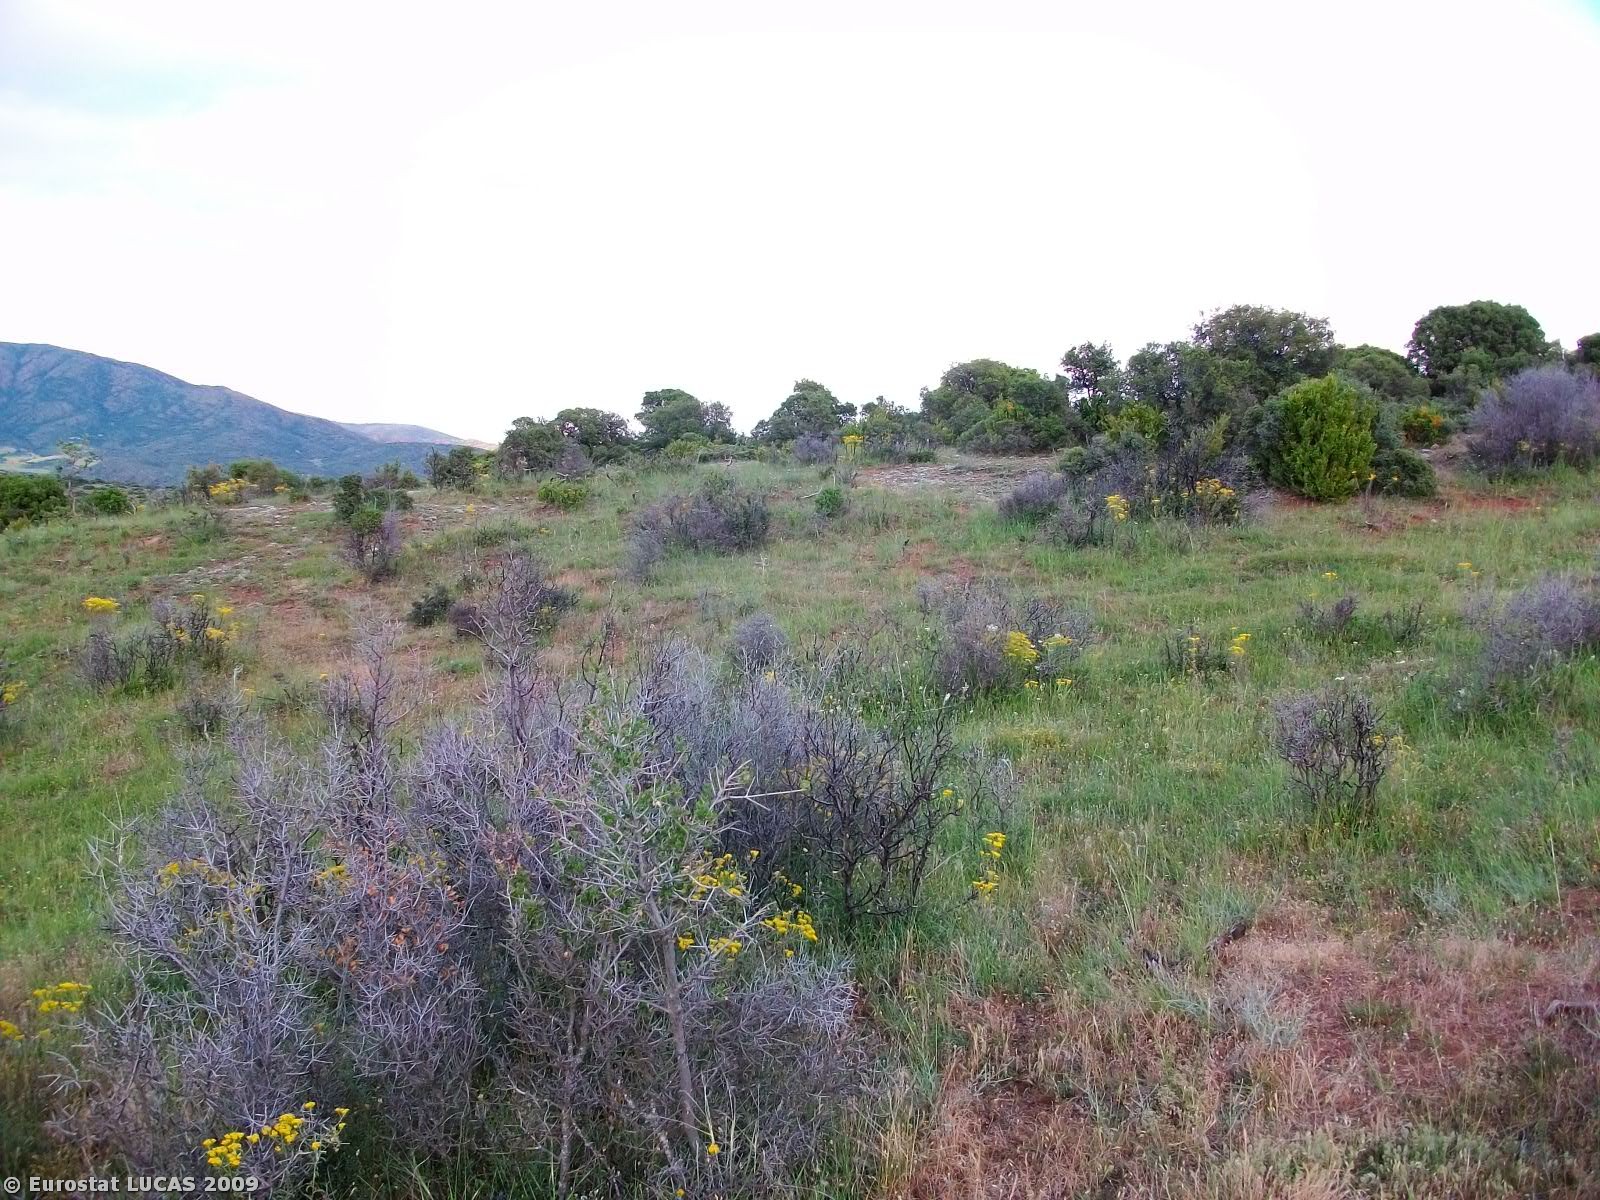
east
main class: Shrubland
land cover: Shrubland without tree cover
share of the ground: 25 - 50 %
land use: Agriculture (excluding fallow land and kitchen gardens)
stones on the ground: 25 - 50 %
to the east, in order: Shrubland without tree cover
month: June
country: GR
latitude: 40.0221
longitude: 21.6934
